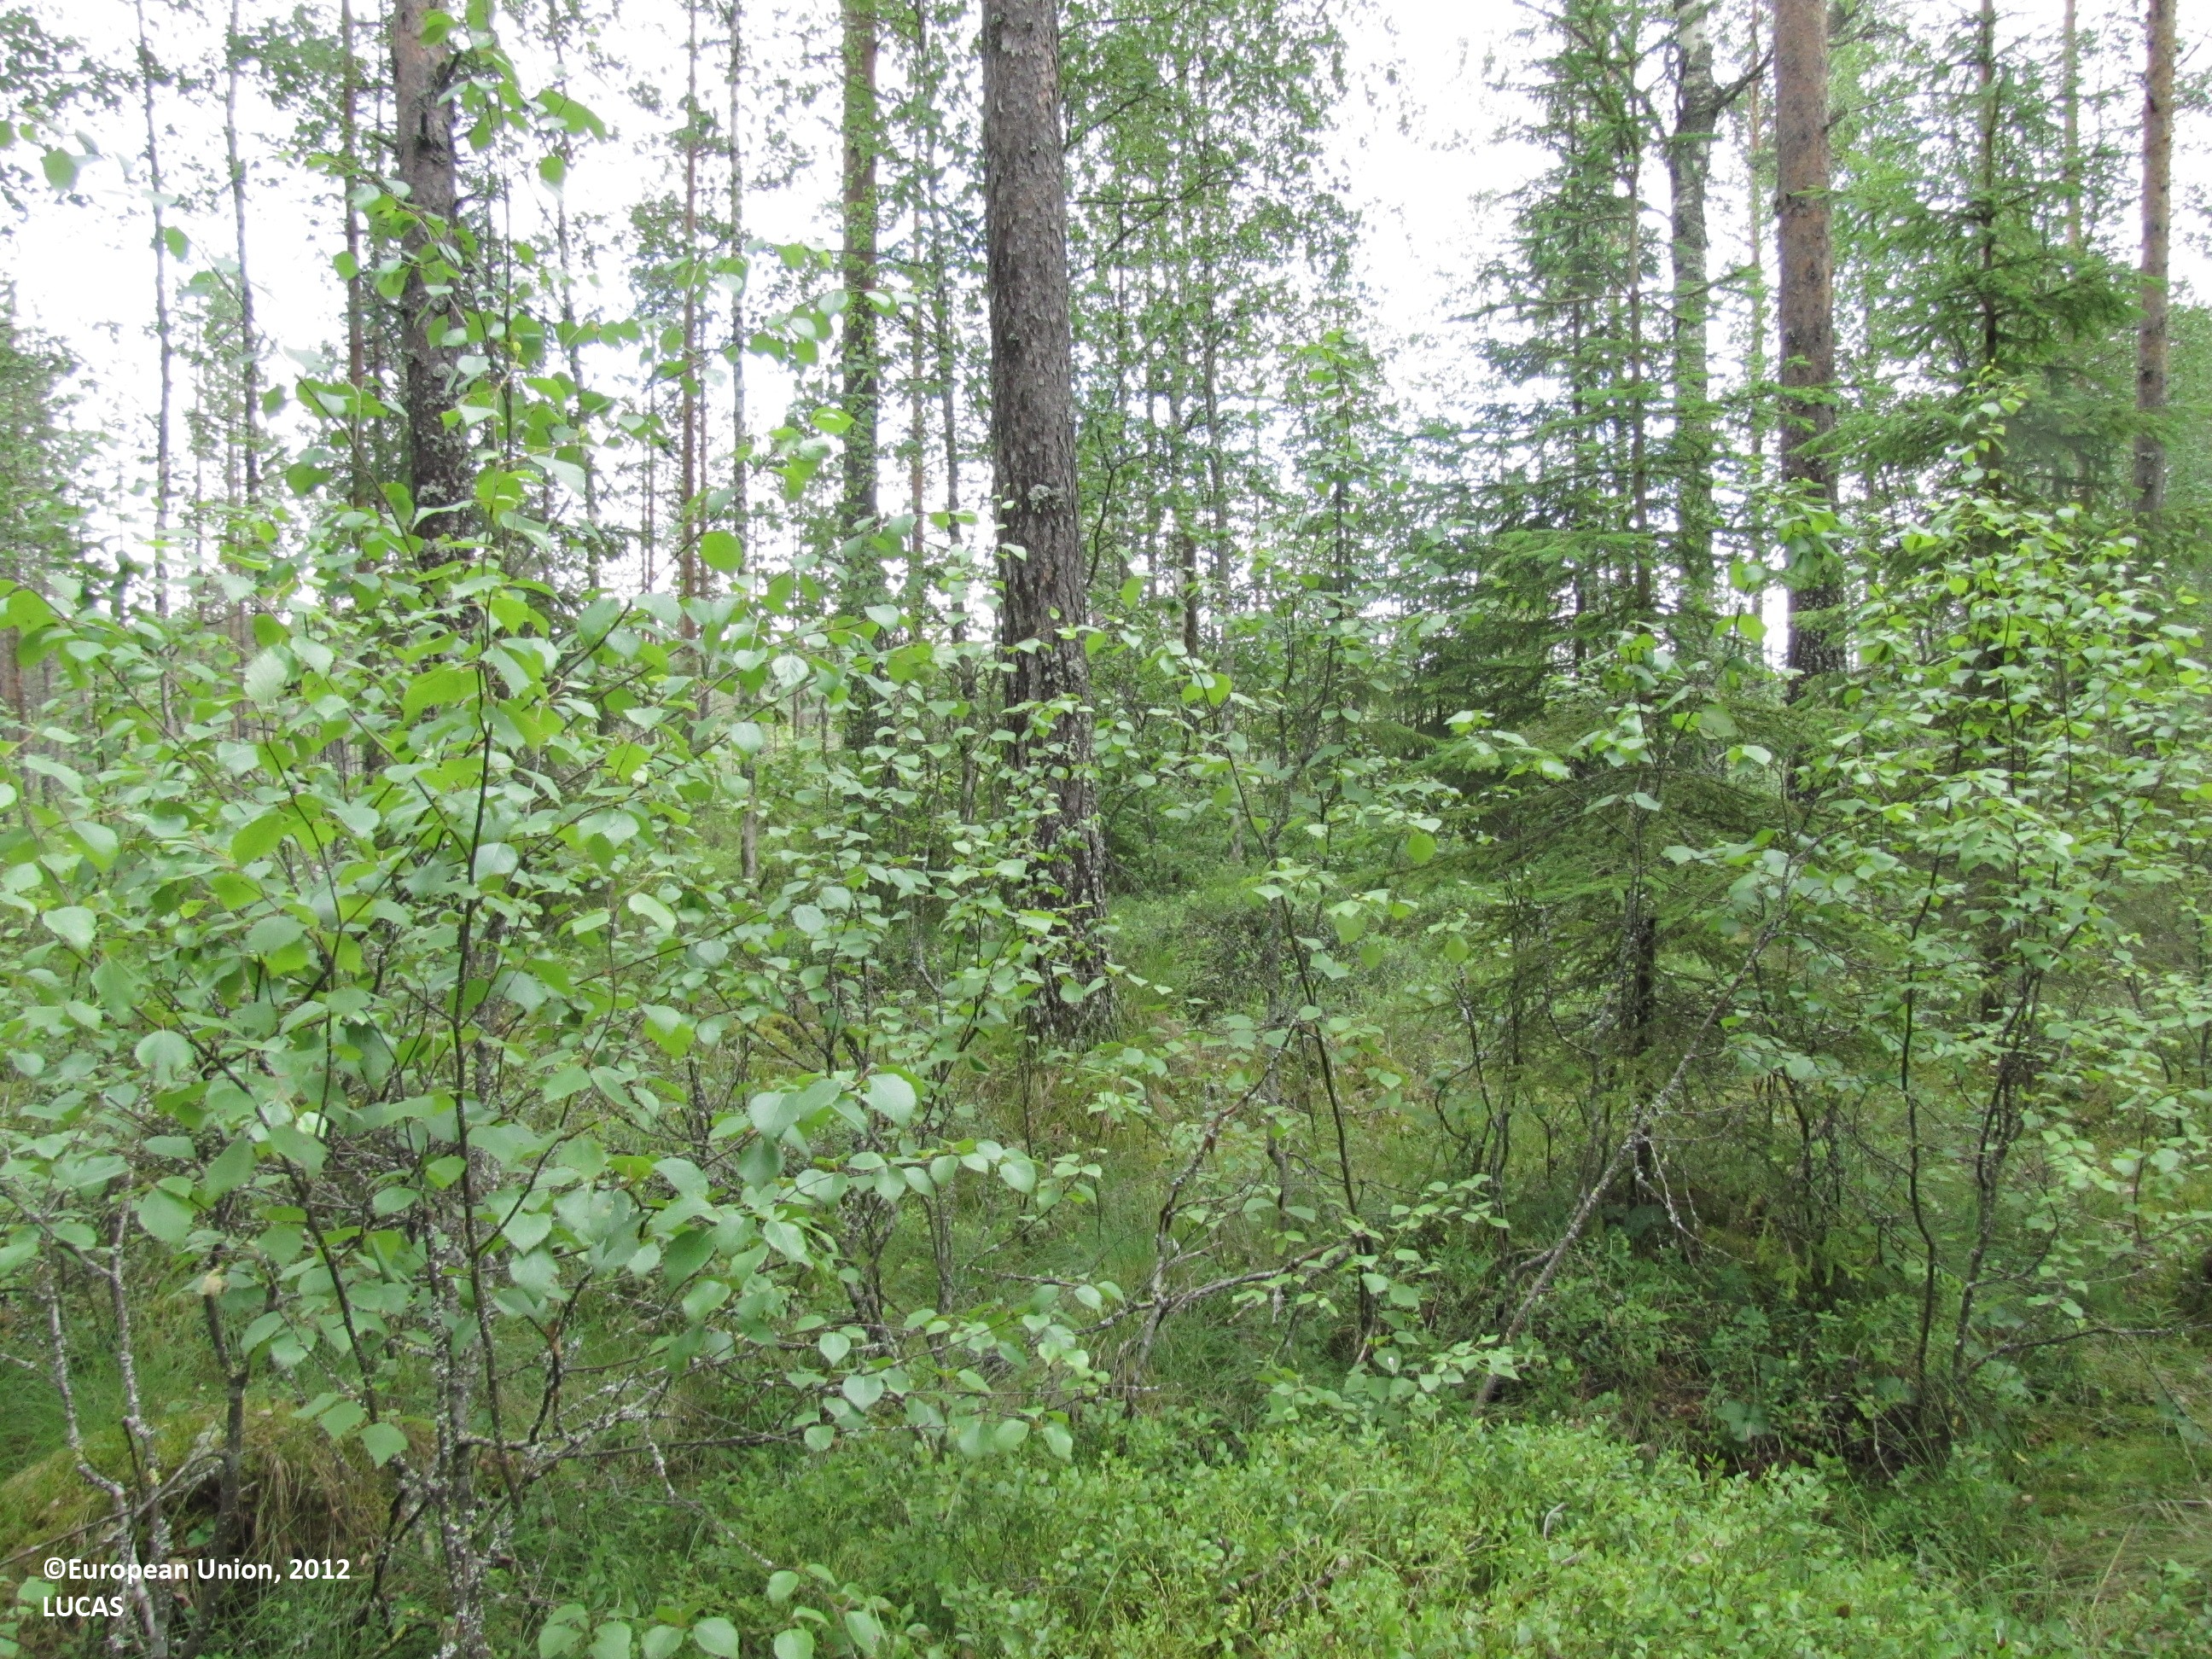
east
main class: Woodland
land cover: Pine dominated coniferous woodland
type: mire and swamp forests
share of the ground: > 75 %
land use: Community services
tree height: > 5 m
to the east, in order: Pine dominated coniferous woodland; Ditches and canals; Pine dominated coniferous woodland; Ditches and canals; Spruce dominated coniferous woodland; Ditches and canals; Pine dominated coniferous woodland; Ditches and canals; Pine dominated coniferous woodland; Ditches and canals; Pine dominated coniferous woodland; Ditches and canals; Pine dominated coniferous woodland; Ditches and canals; Pine dominated coniferous woodland
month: July
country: FI
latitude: 62.3464
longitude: 23.9277
